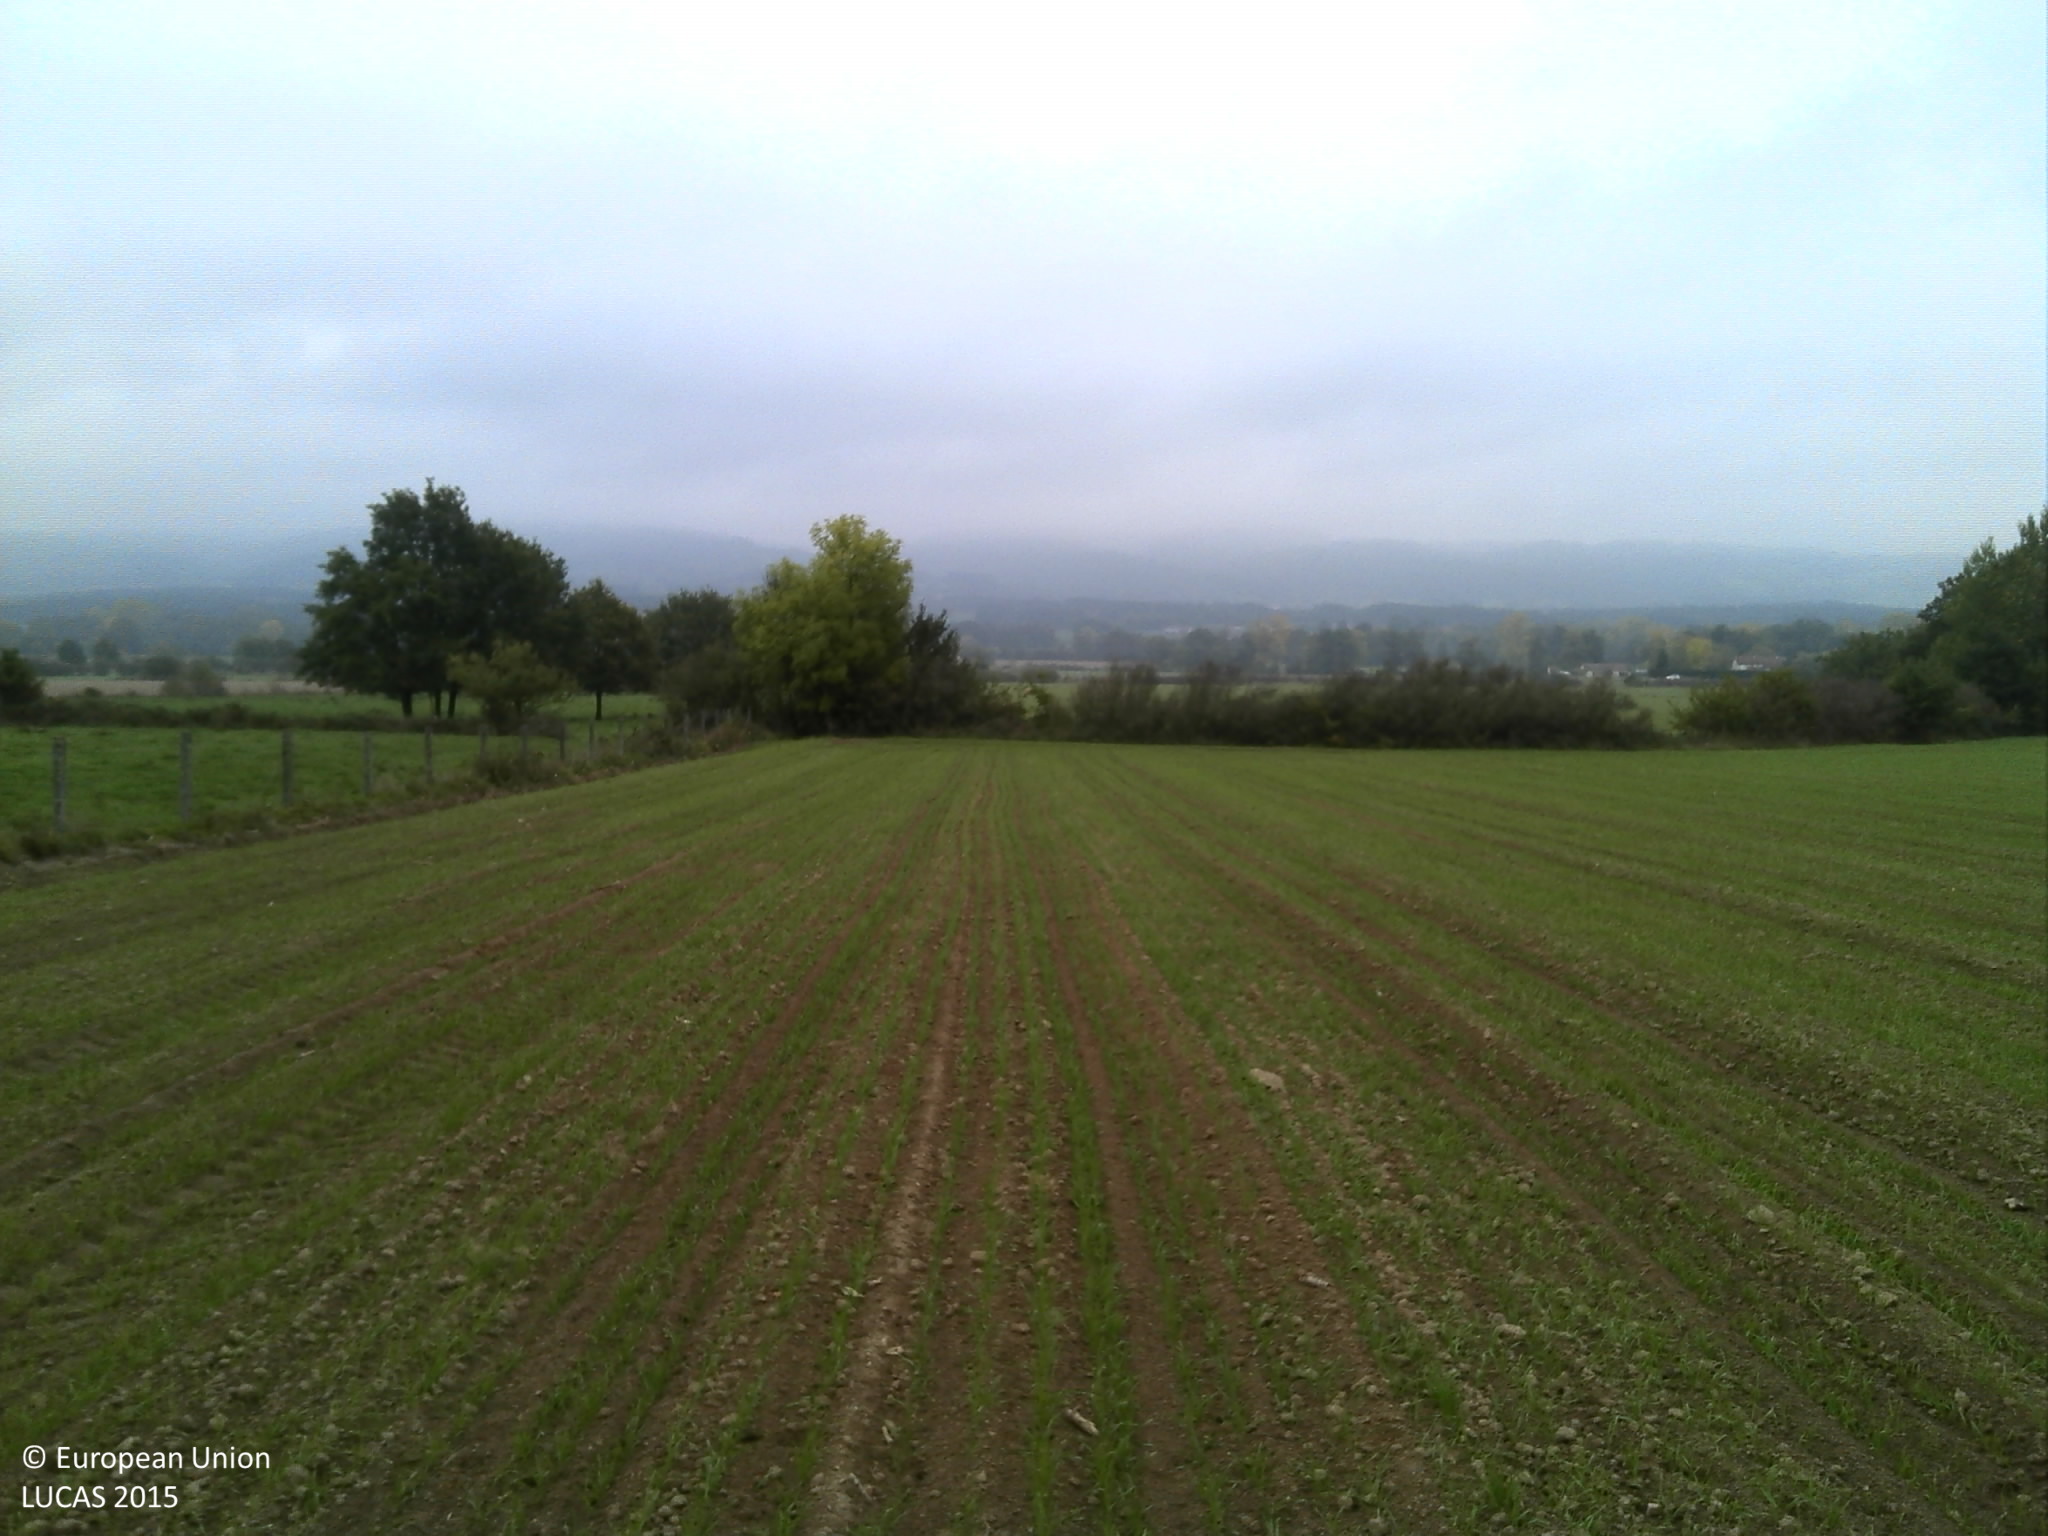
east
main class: Cropland
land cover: Common wheat
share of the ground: 25 - 50 %
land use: Agriculture (excluding fallow land and kitchen gardens)
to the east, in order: Common wheat; Abandoned hedges; Fences; Grassland without tree/shrub cover
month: October
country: FR
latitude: 45.4981
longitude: 3.7189
